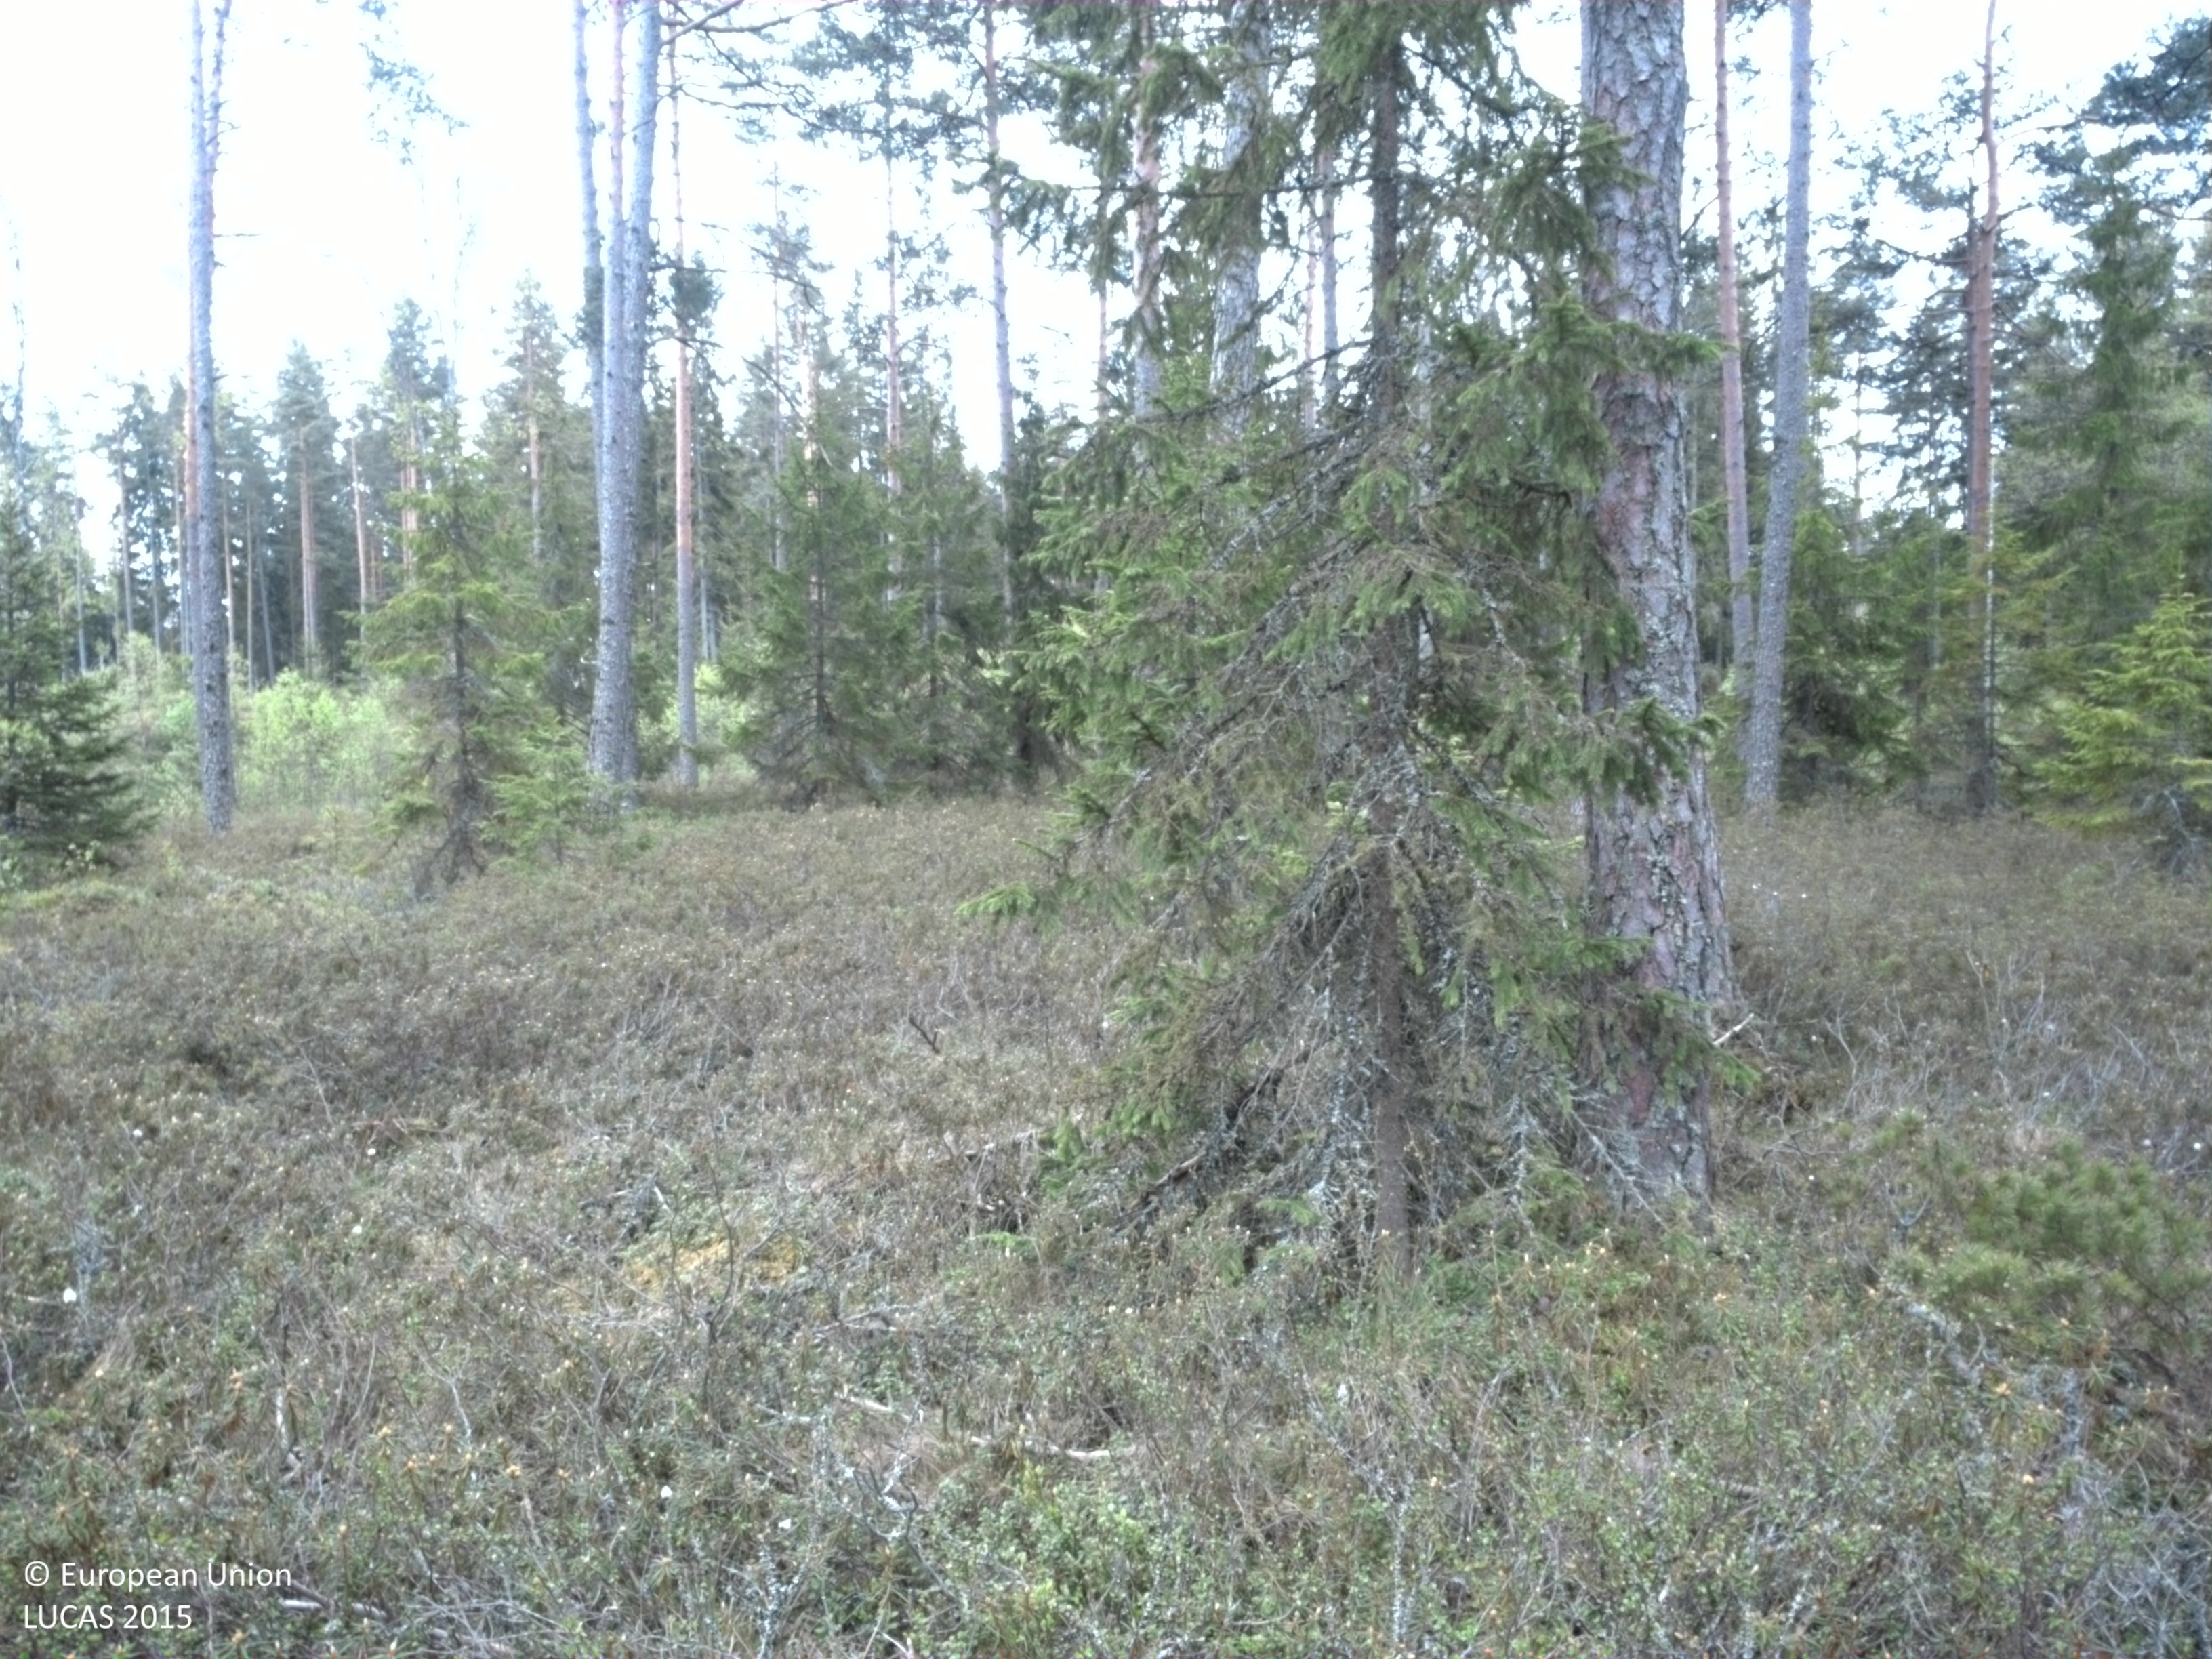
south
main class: Woodland
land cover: Pine dominated coniferous woodland
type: boreal forest
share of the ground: 50 - 75 %
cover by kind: coniferous forest trees 50 %, shrubs 25 %, lichens and mosses 20 %, broadleaved forest trees 5 %
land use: Forestry
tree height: > 5 m
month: May
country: SE
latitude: 56.9688
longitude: 15.1130
